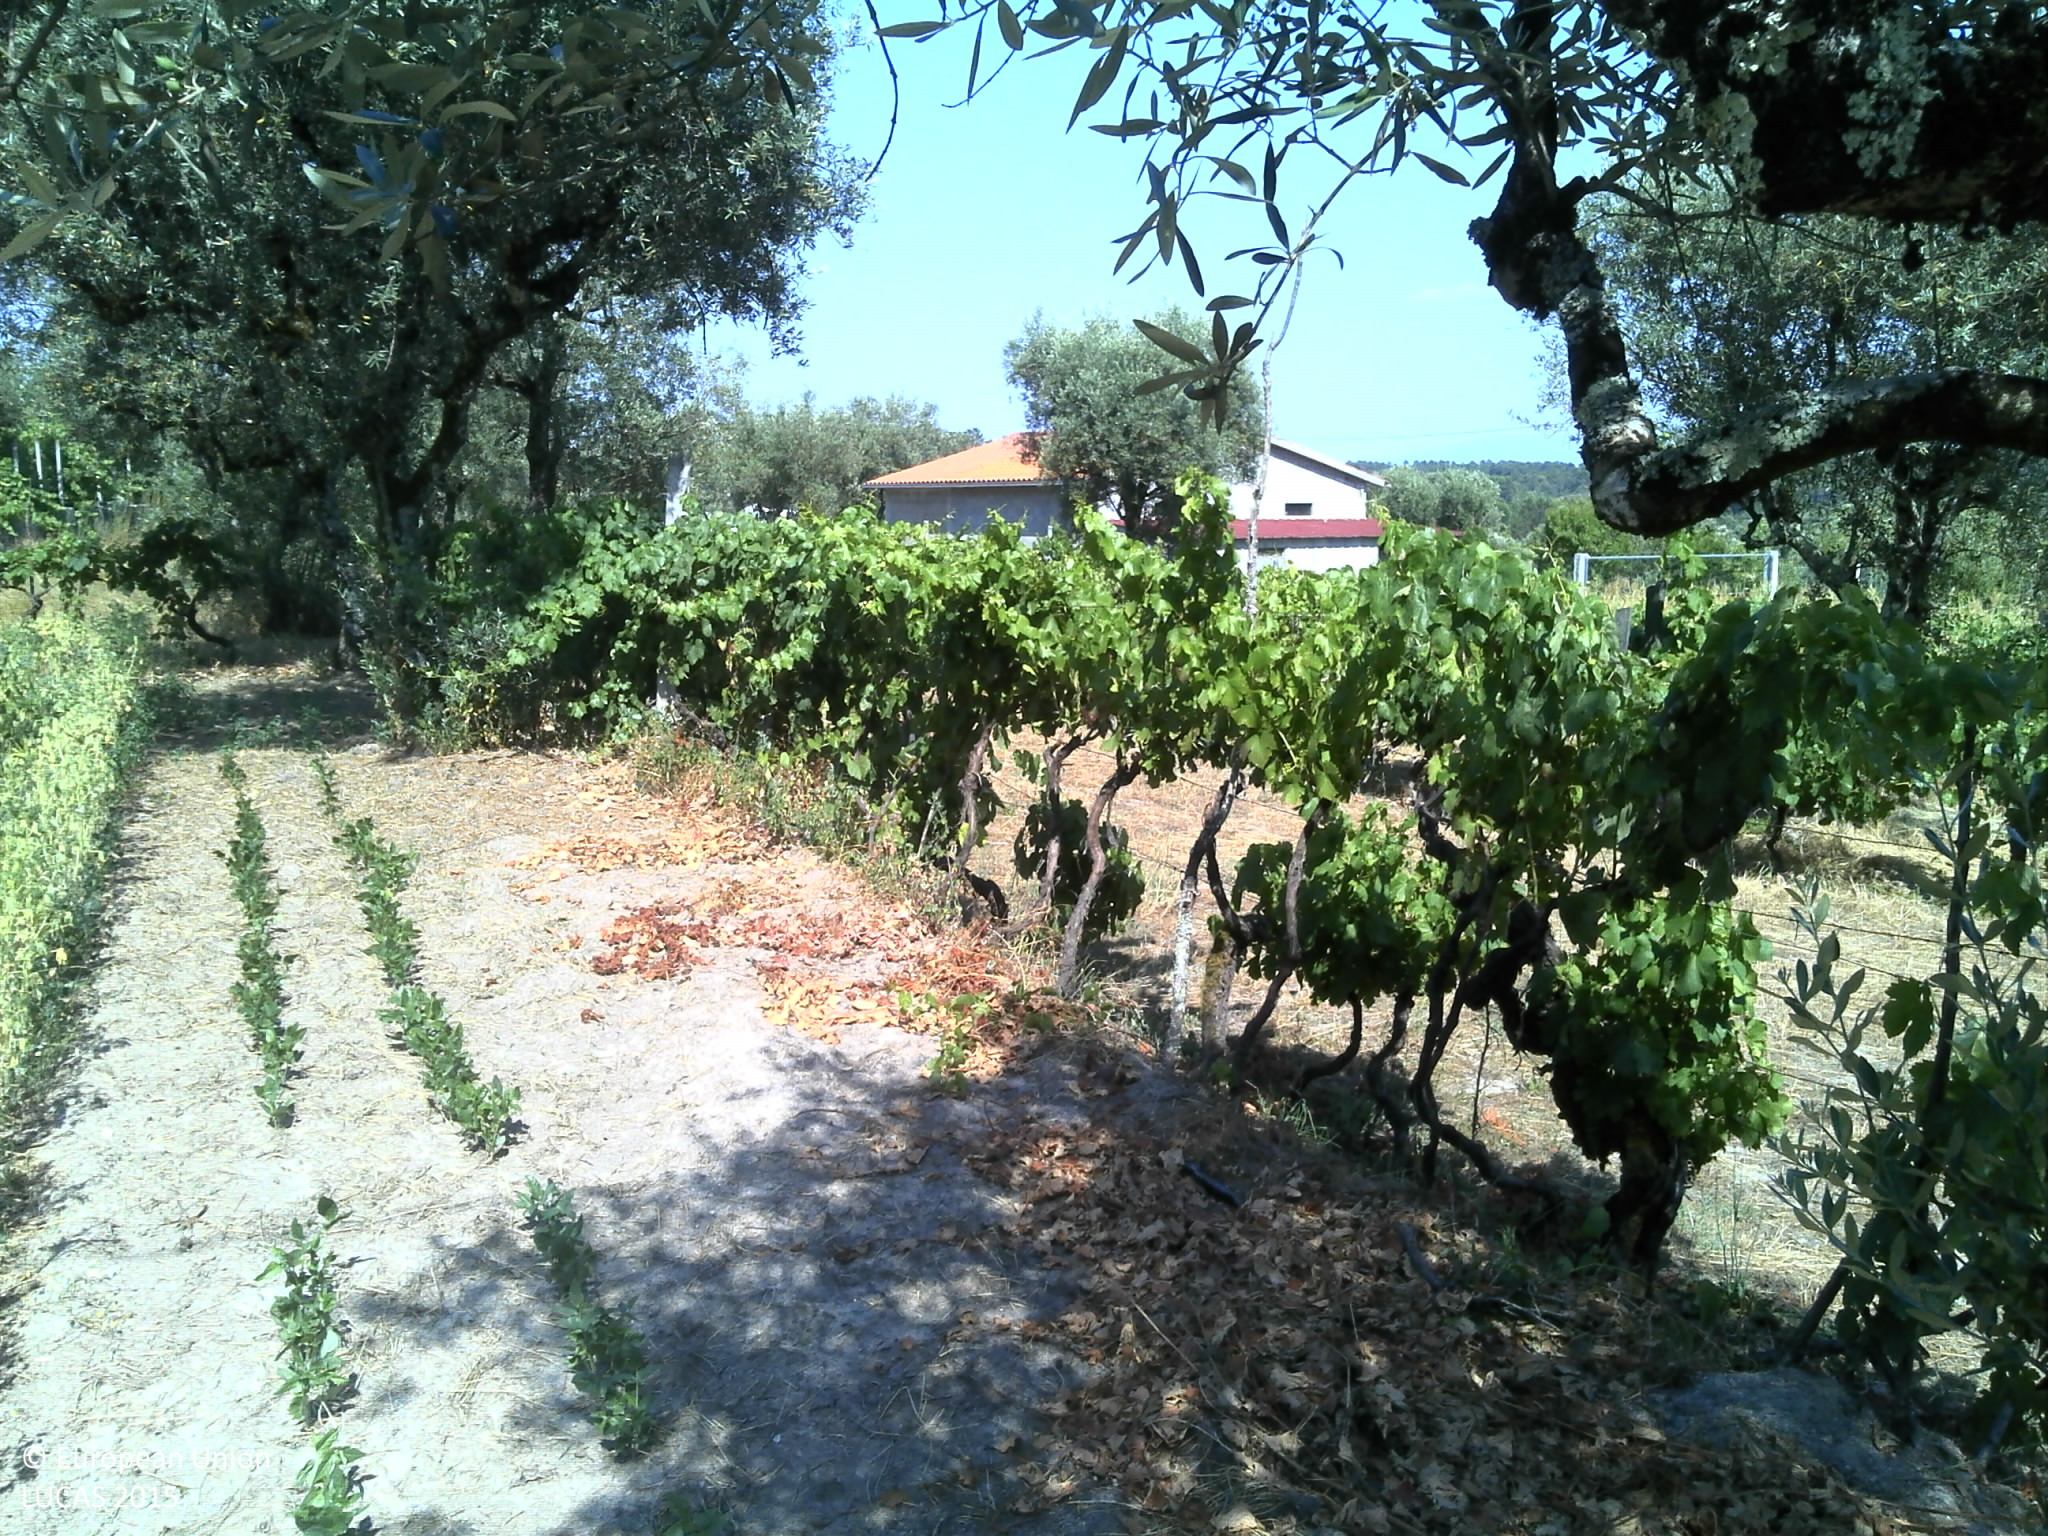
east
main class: Cropland
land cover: Dry pulses
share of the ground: 25 - 50 %
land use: Agriculture (excluding fallow land and kitchen gardens)
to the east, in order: Dry pulses; Abandoned hedges; Vineyards; Spontaneously vegetated surfaces; Vineyards; Artificial constructions in urban areas; Other root crops; Dry stone walls; Tracks; Spontaneously vegetated surfaces; Other fruit trees and berries; Spontaneously vegetated surfaces; Abandoned hedges; Vineyards; Other bare soil; Vineyards; Dry stone walls; Vineyards
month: June
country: PT
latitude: 40.5251
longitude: -7.9109
